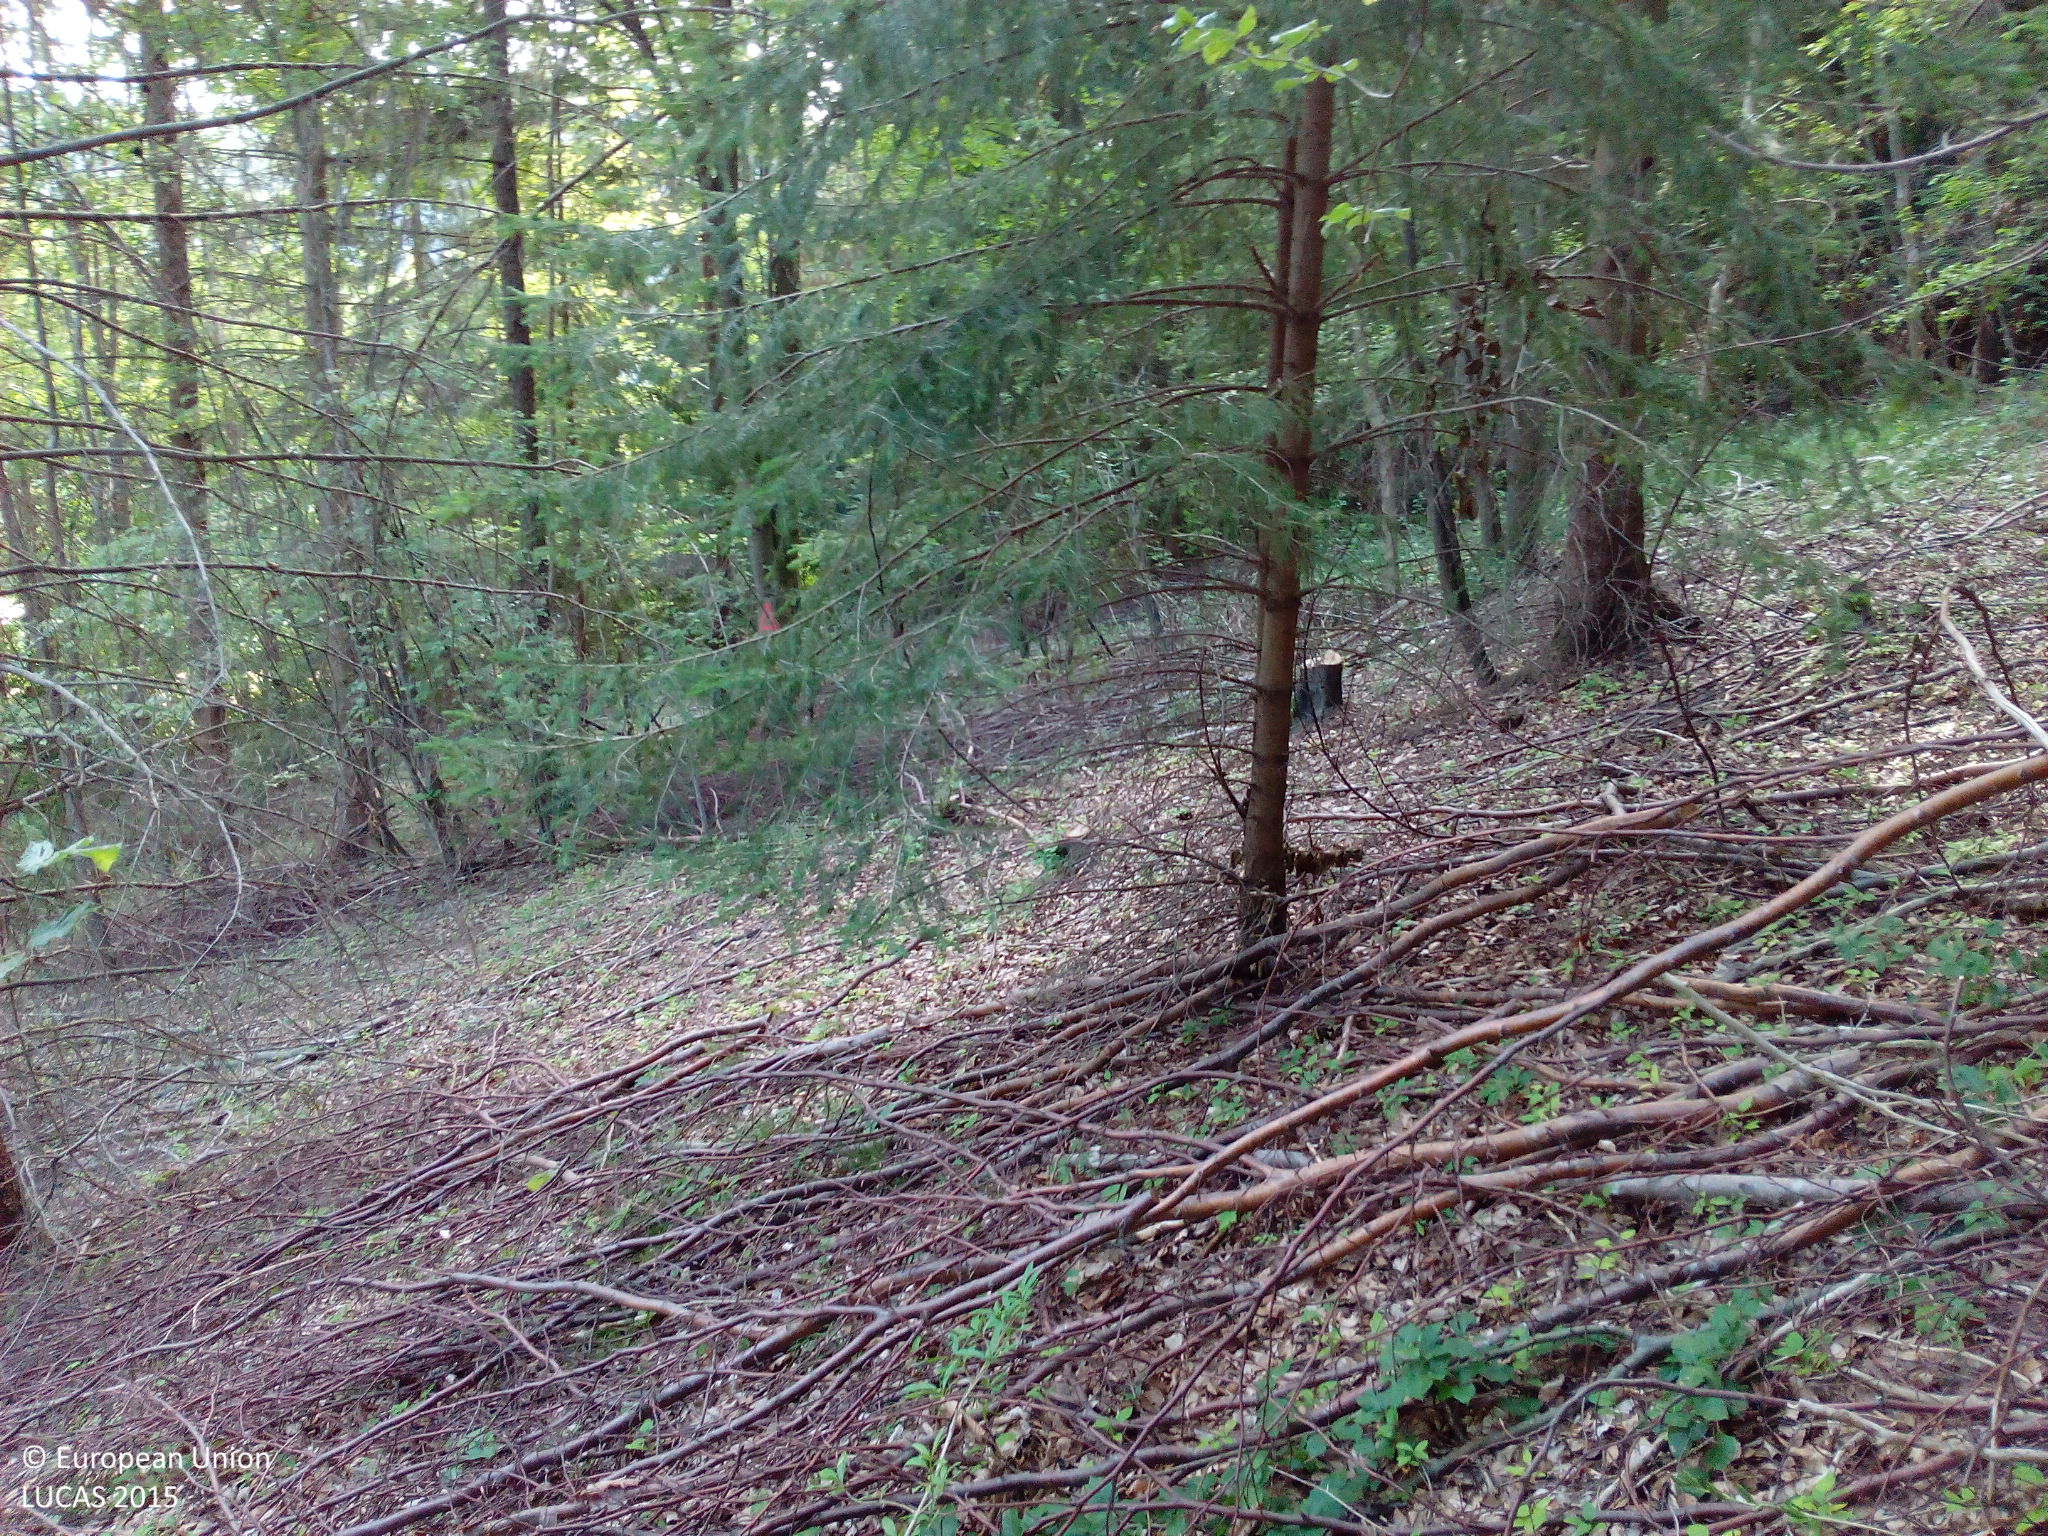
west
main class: Woodland
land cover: Spruce dominated mixed woodland
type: hemiboreal forest and nemoral coniferous forest and mixed broadleaved-coniferous forest
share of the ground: > 75 %
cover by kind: broadleaved forest trees 65 %, coniferous forest trees 25 %, unconsolidated bare surface 10 %
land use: Forestry
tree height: > 5 m
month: July
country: DE
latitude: 48.6010
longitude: 9.6883
